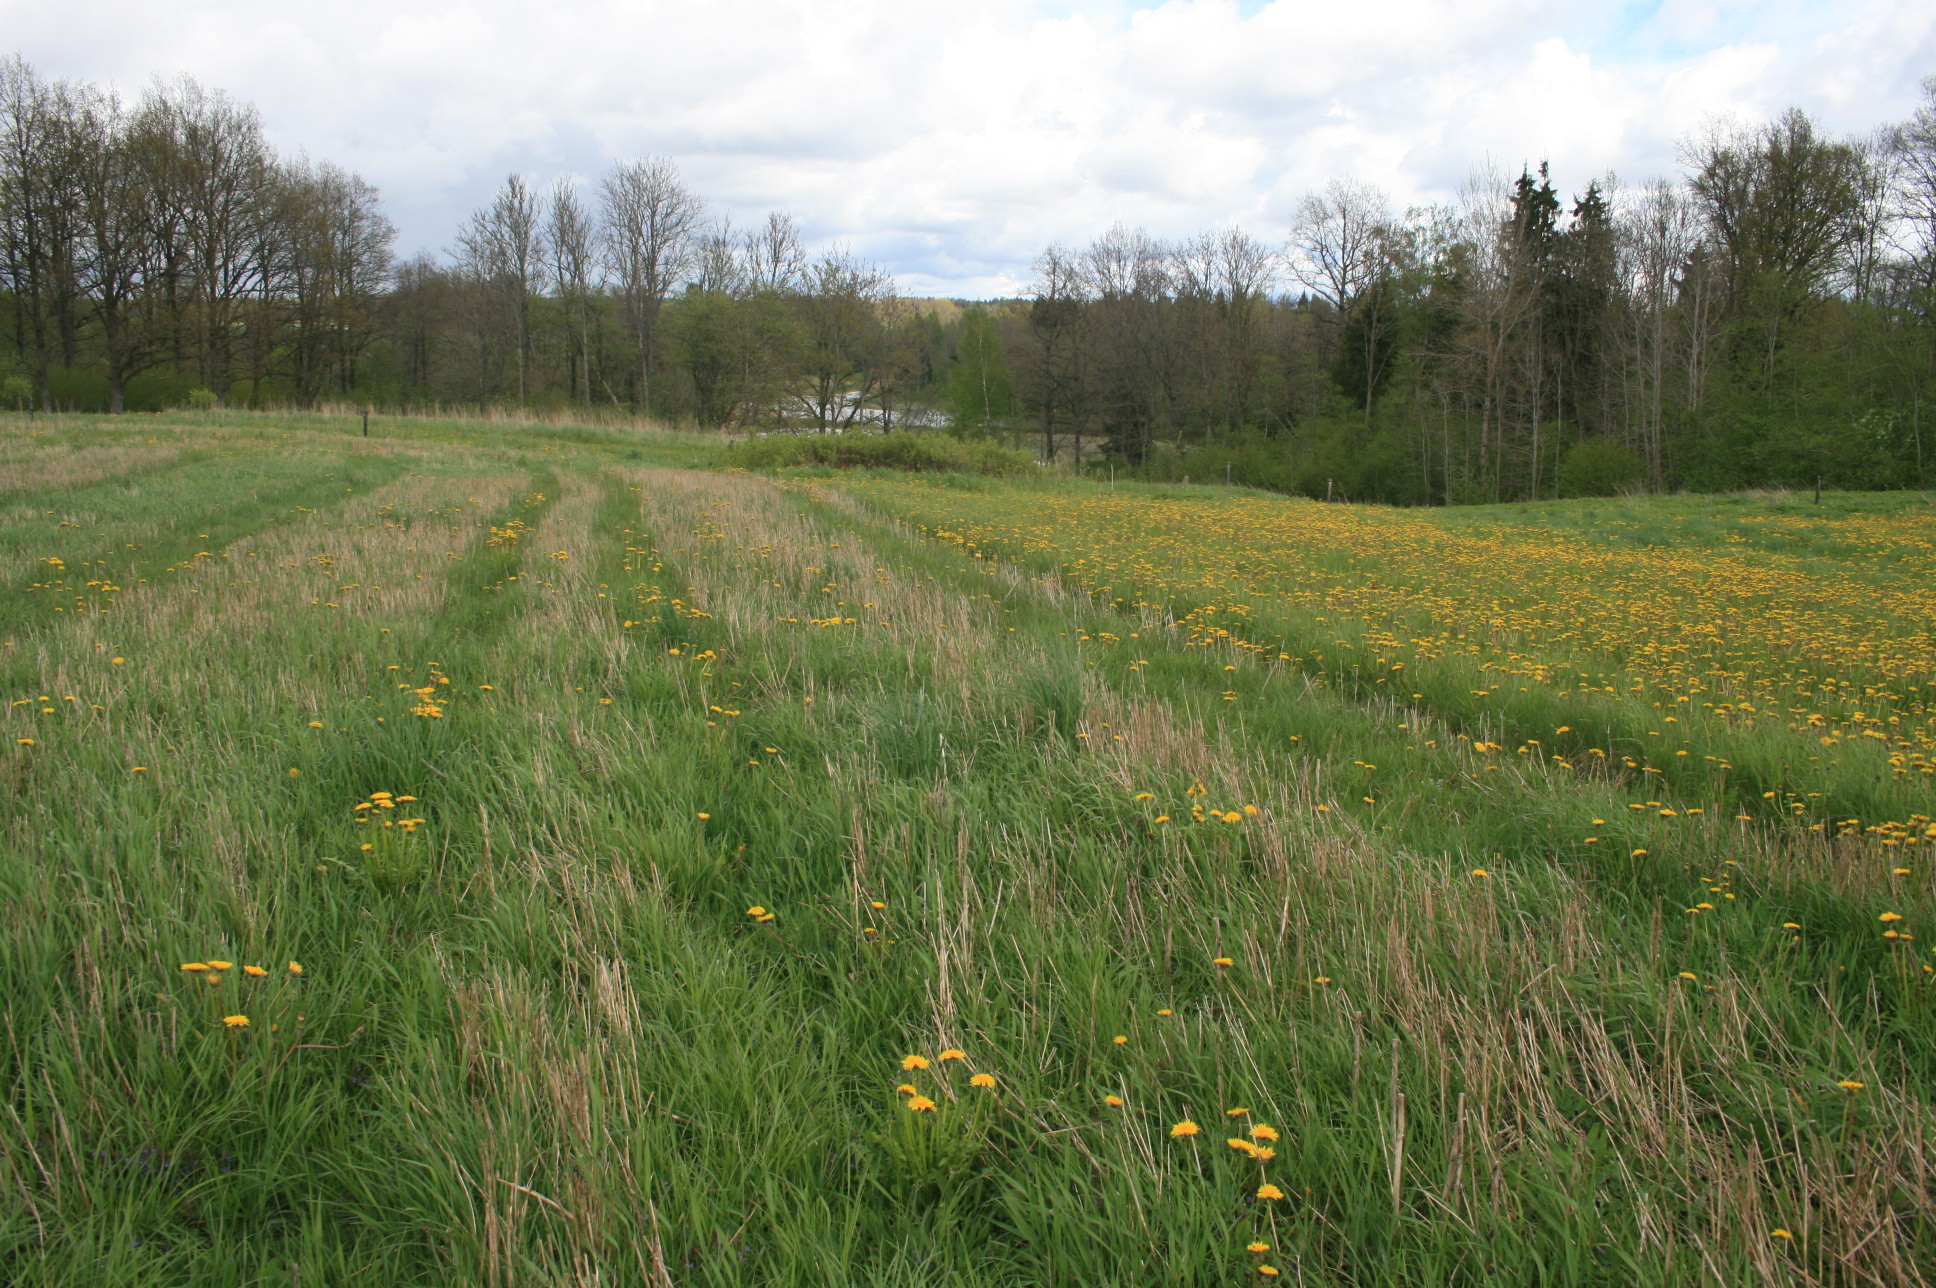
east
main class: Grassland
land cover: Grassland without tree/shrub cover
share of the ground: > 75 %
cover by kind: herbaceous plants 100 %
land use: Agriculture (excluding fallow land and kitchen gardens)
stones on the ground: < 10 %
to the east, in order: Grassland without tree/shrub cover; Single bushes/trees; Grassland without tree/shrub cover; Broadleaved woodland; Grassland without tree/shrub cover; Broadleaved woodland; Inland fresh running water
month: May
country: LT
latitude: 56.2521
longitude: 22.0759
